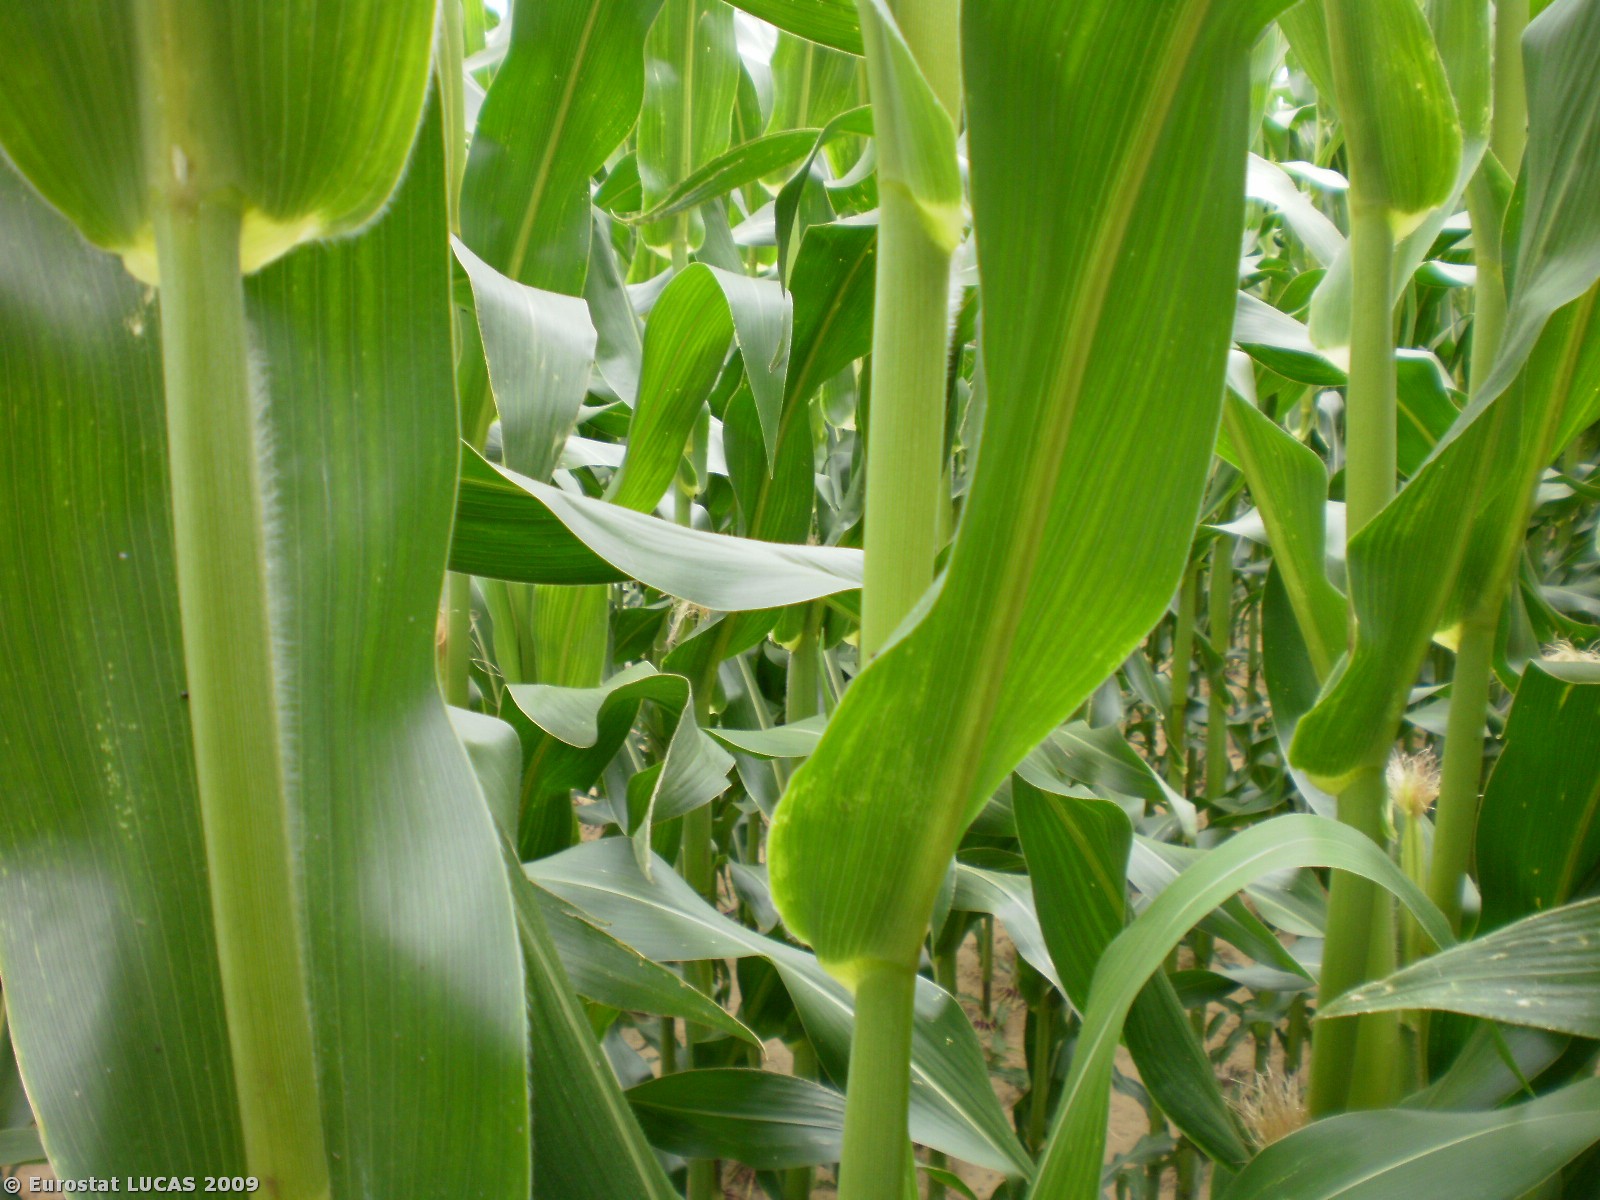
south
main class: Cropland
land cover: Maize
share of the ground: > 75 %
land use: Agriculture (excluding fallow land and kitchen gardens)
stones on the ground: < 10 %
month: July
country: BE
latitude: 50.8225
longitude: 2.7917
